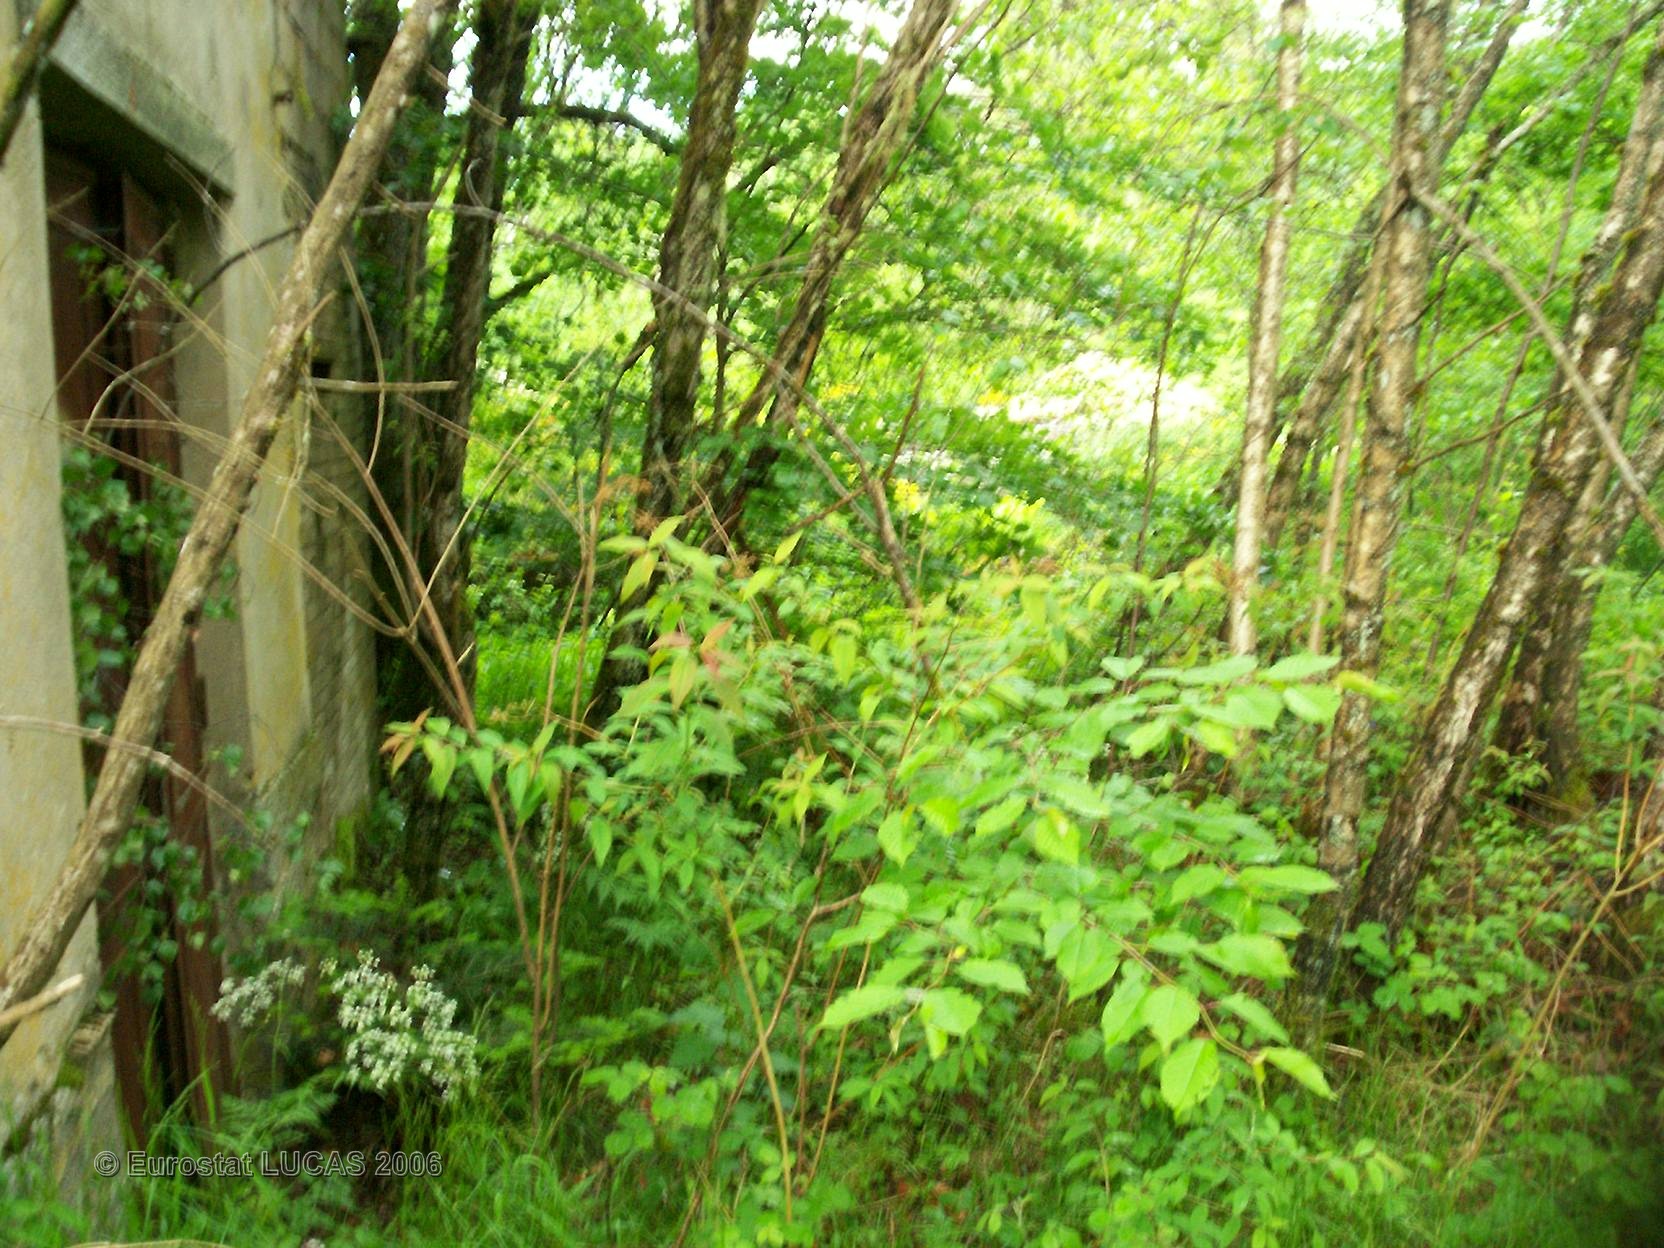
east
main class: Woodland
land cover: Broadleaved forest
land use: Unused
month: June
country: FR
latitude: 47.9423
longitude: 6.7747
